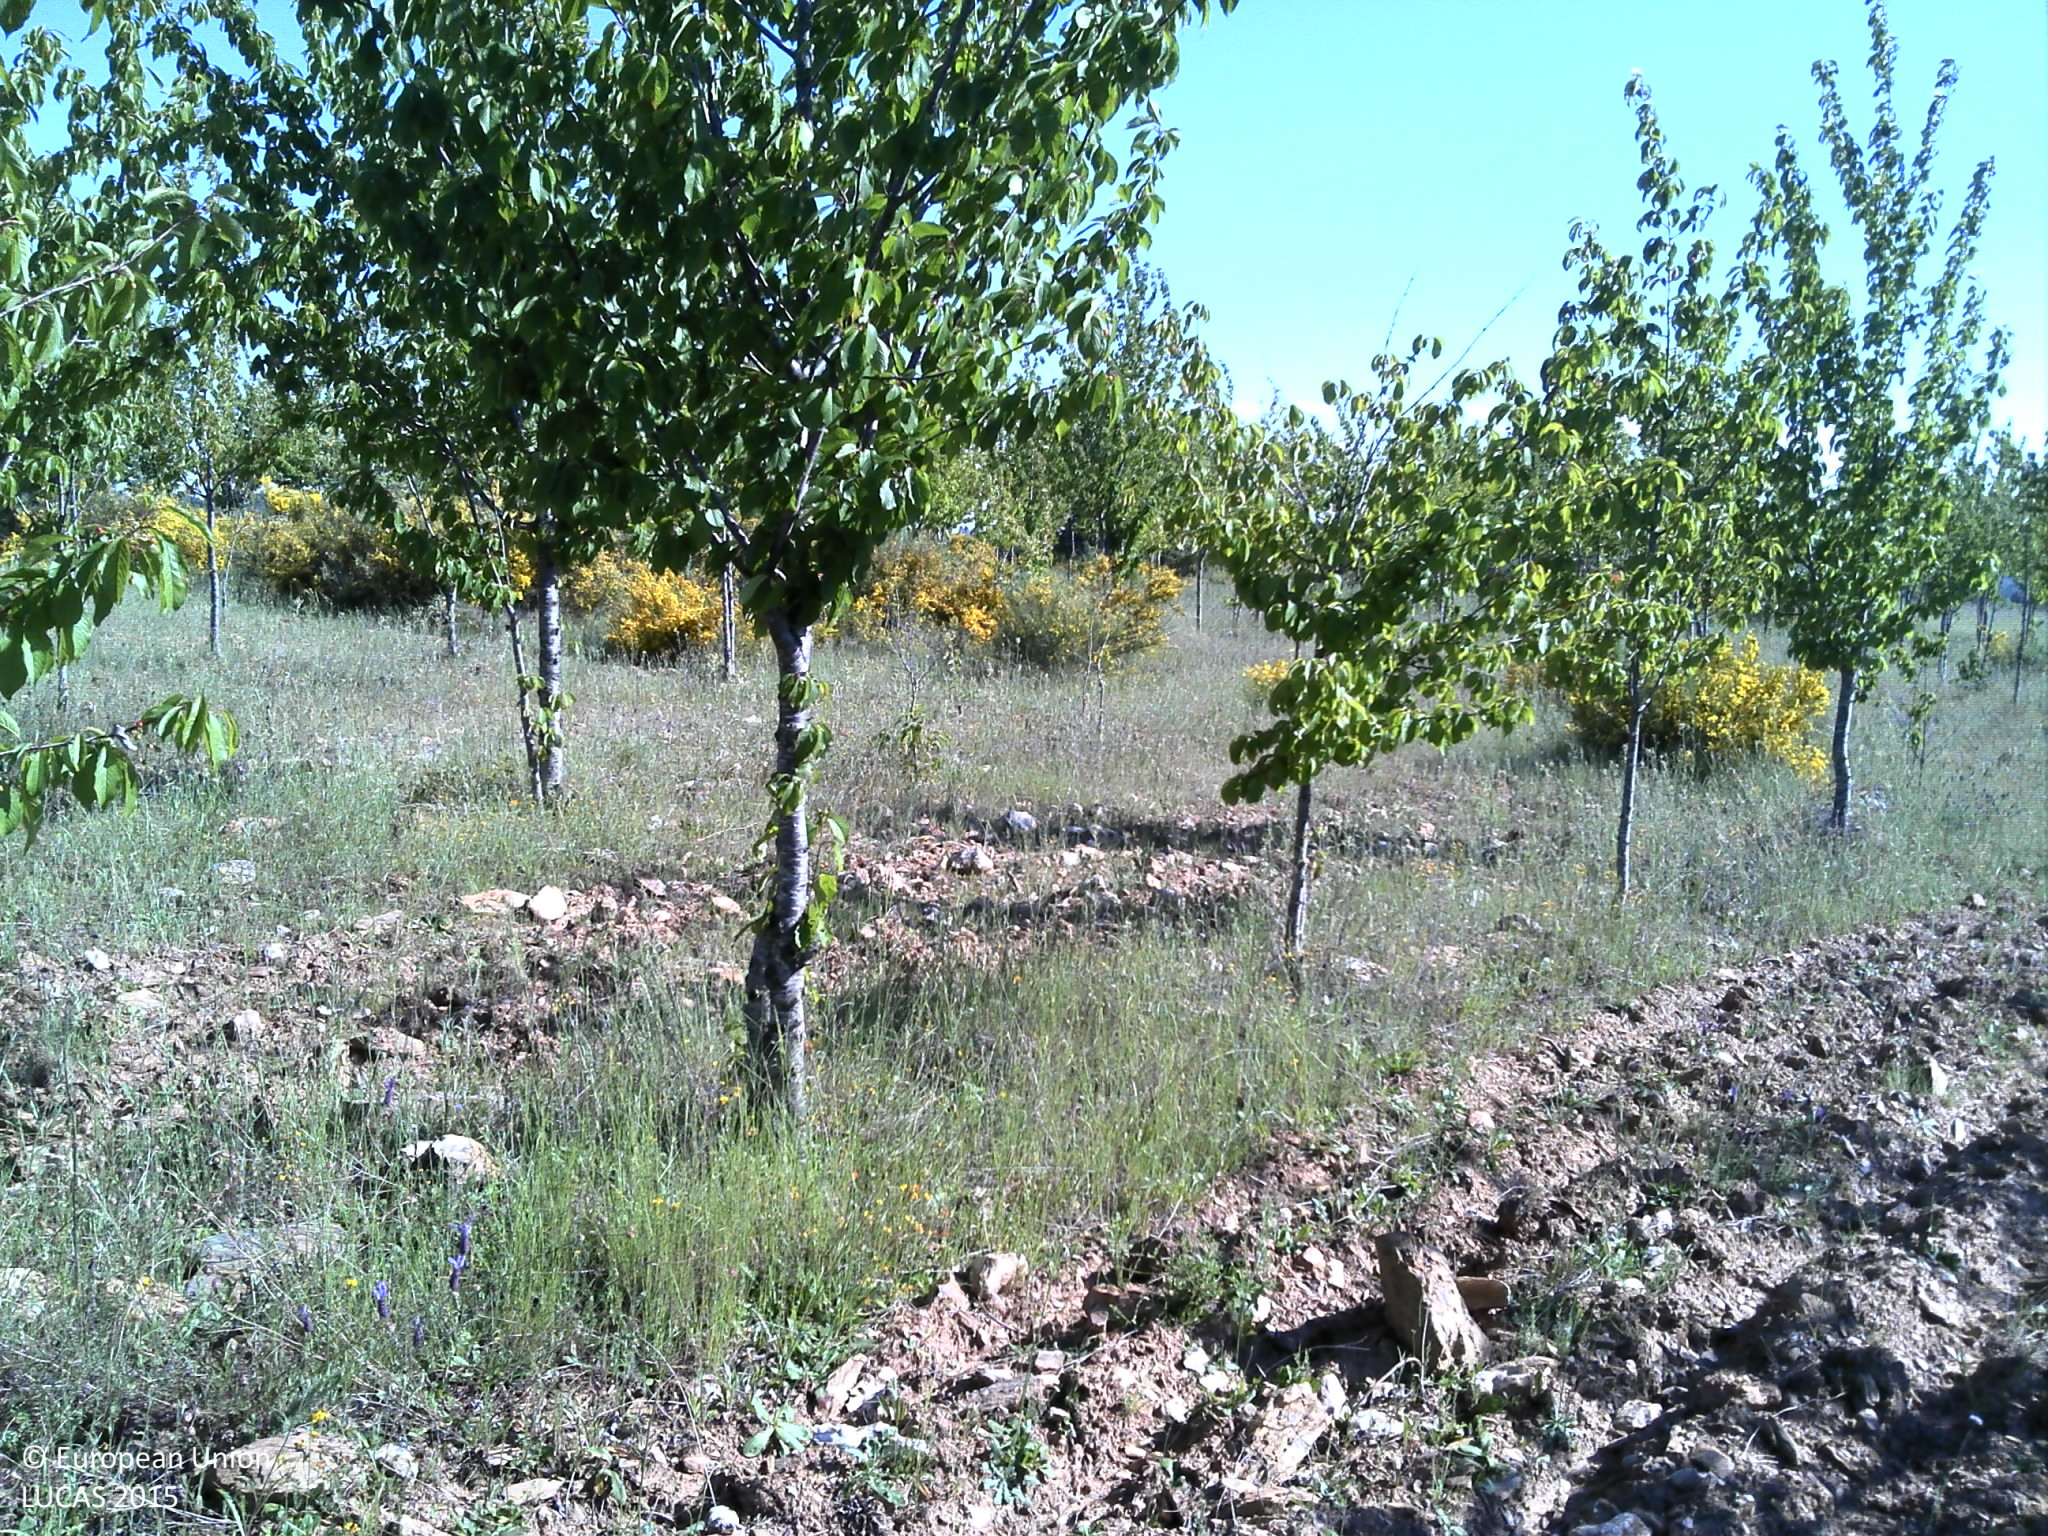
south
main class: Cropland
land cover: Cherry fruit
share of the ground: 25 - 50 %
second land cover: Spontaneously vegetated surfaces
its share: 25 - 50 %
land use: Agriculture (excluding fallow land and kitchen gardens)
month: May
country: PT
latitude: 41.6564
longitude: -6.3981
